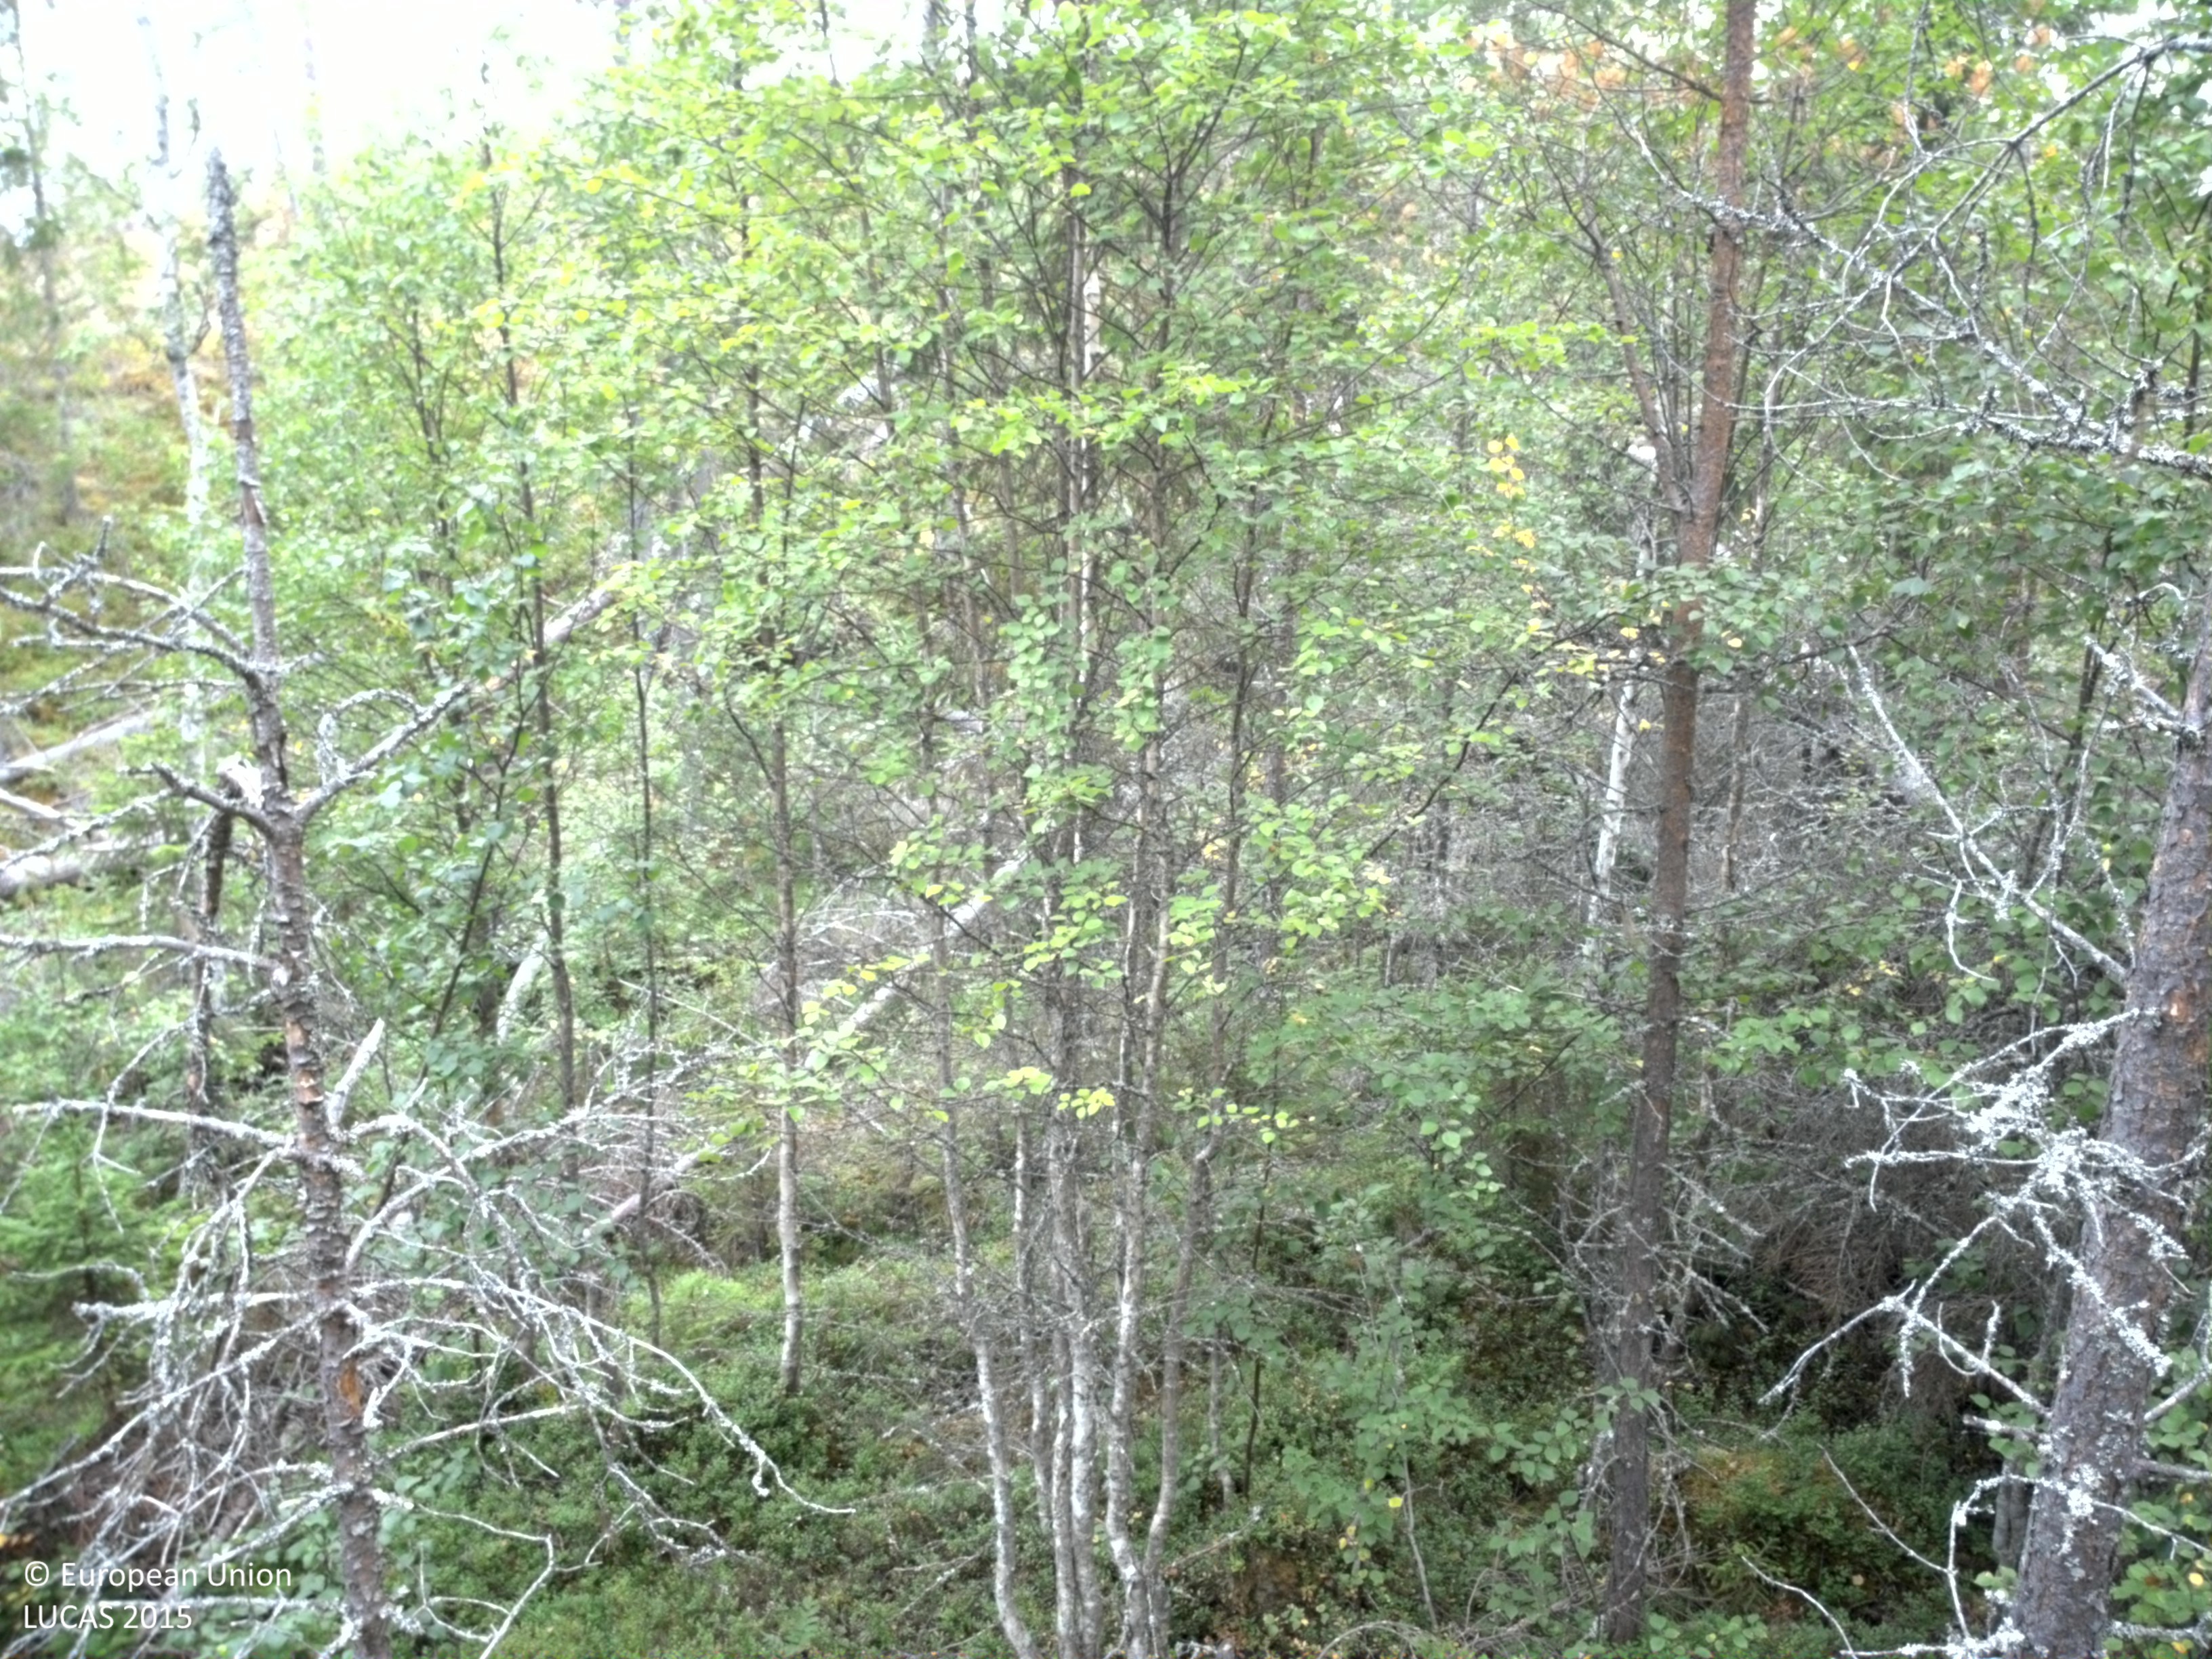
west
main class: Woodland
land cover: Pine dominated mixed woodland
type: boreal forest
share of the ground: 50 - 75 %
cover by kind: coniferous forest trees 40 %, broadleaved forest trees 20 %, shrubs 20 %, lichens and mosses 20 %
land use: Forestry
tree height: > 5 m
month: August
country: SE
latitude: 61.7166
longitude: 14.9969
